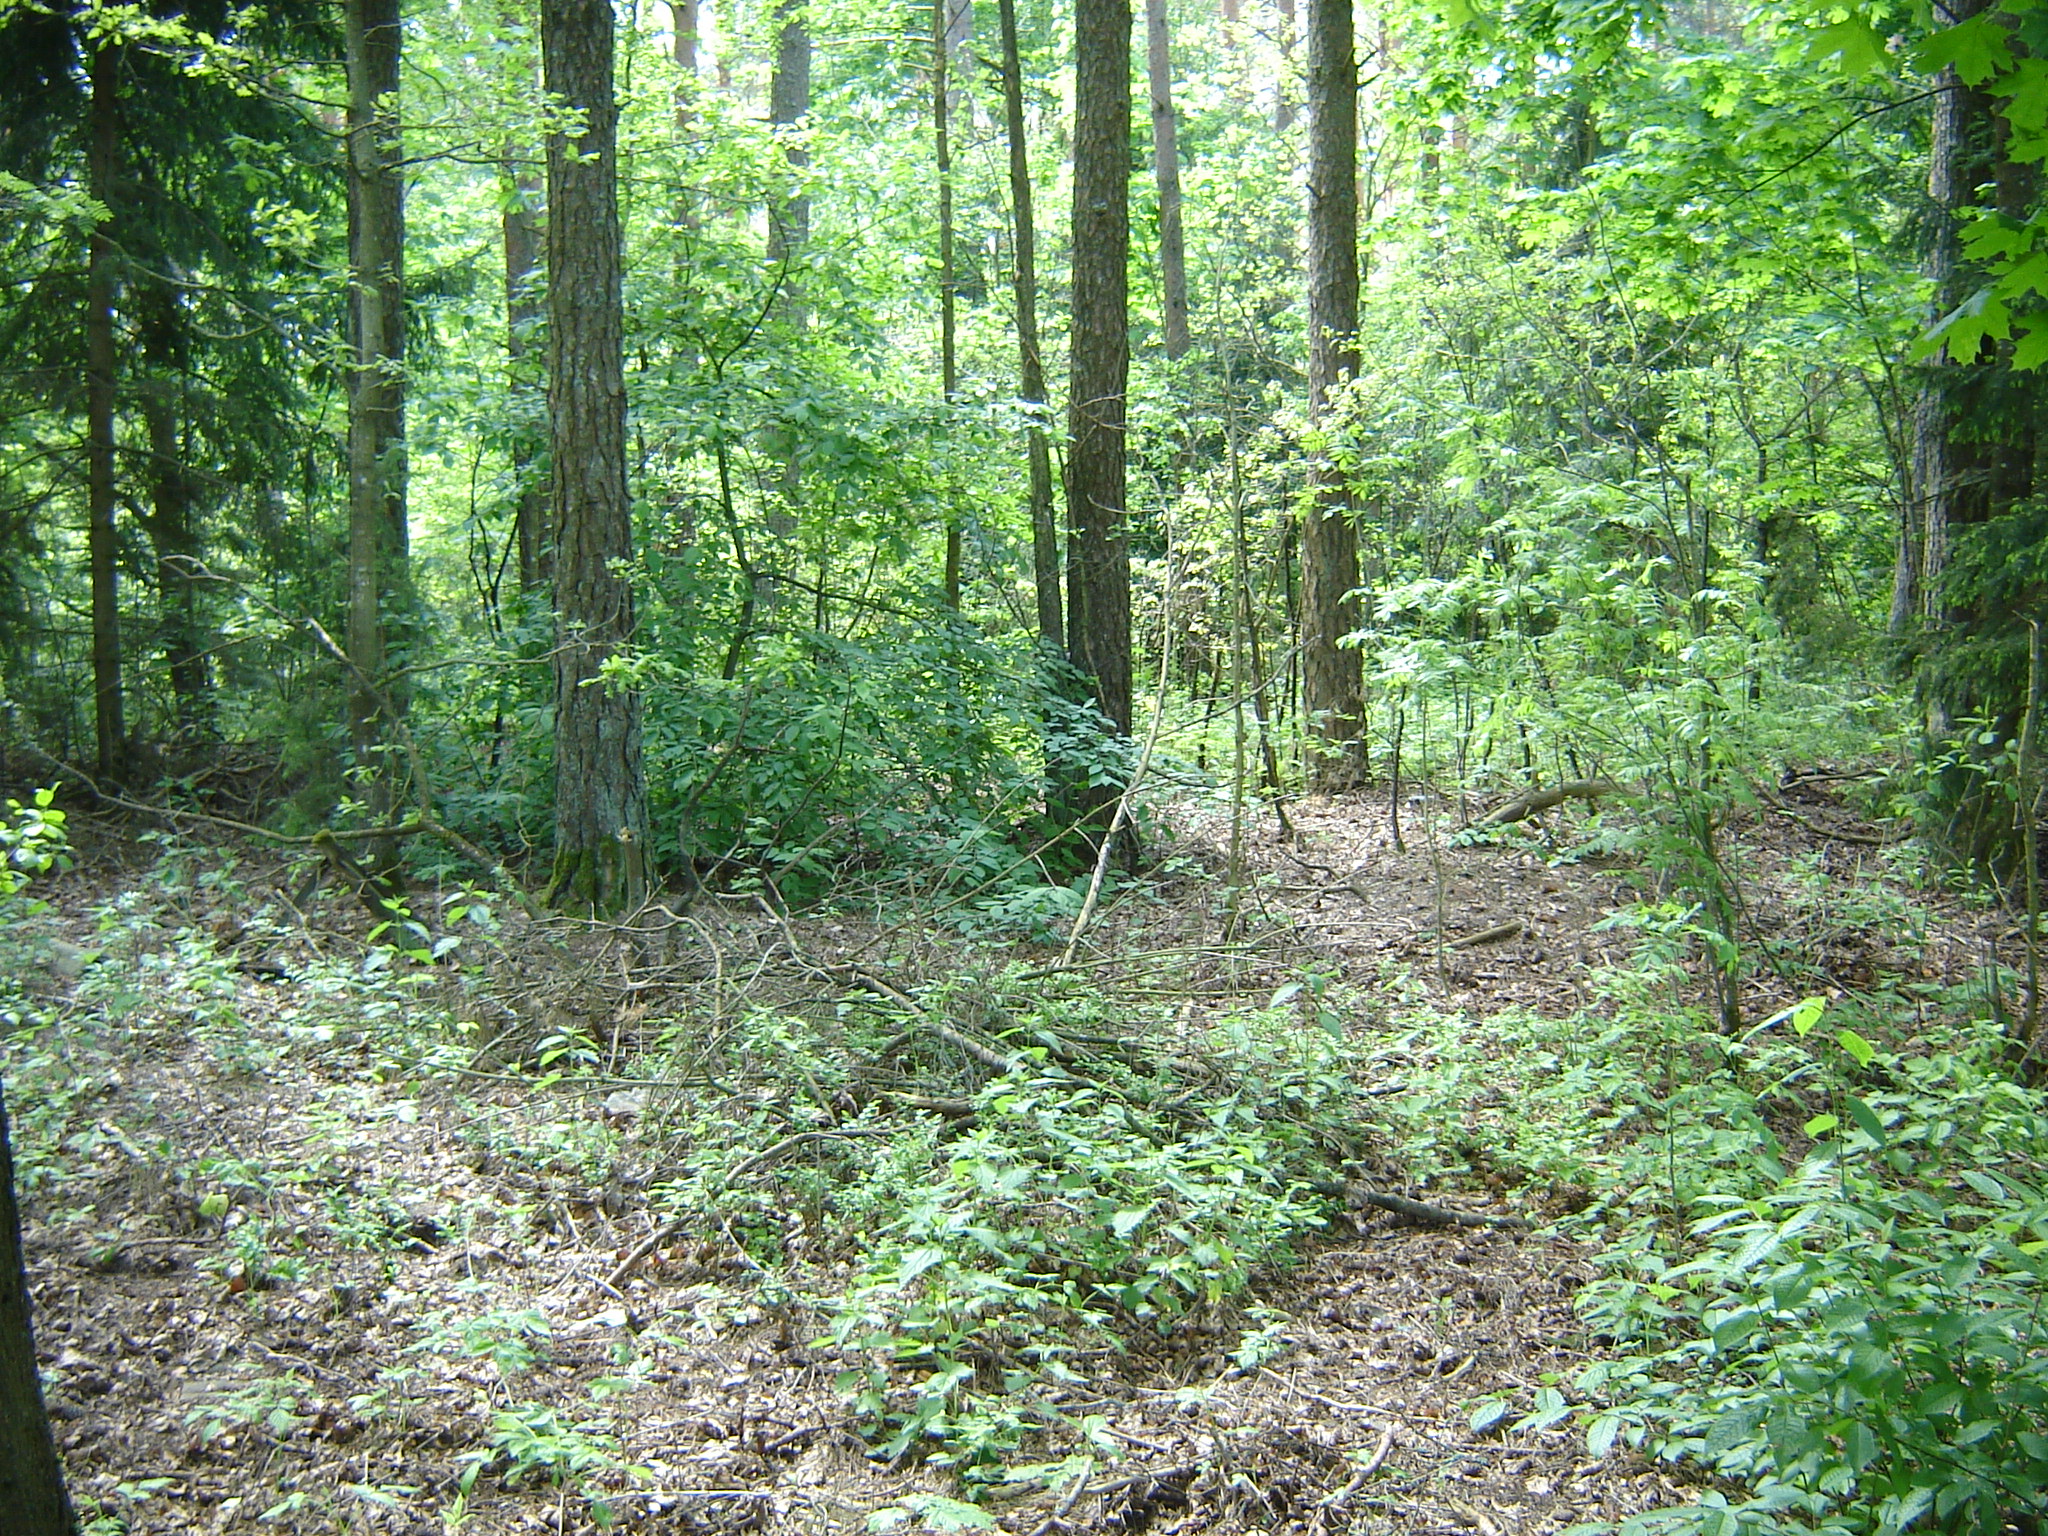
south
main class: Woodland
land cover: Other mixed woodland
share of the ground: > 75 %
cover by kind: coniferous forest trees 55 %, broadleaved forest trees 30 %, unconsolidated bare surface 10 %, herbaceous plants 5 %
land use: Forestry
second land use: Residential
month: May
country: LT
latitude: 55.7181
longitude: 25.3215
